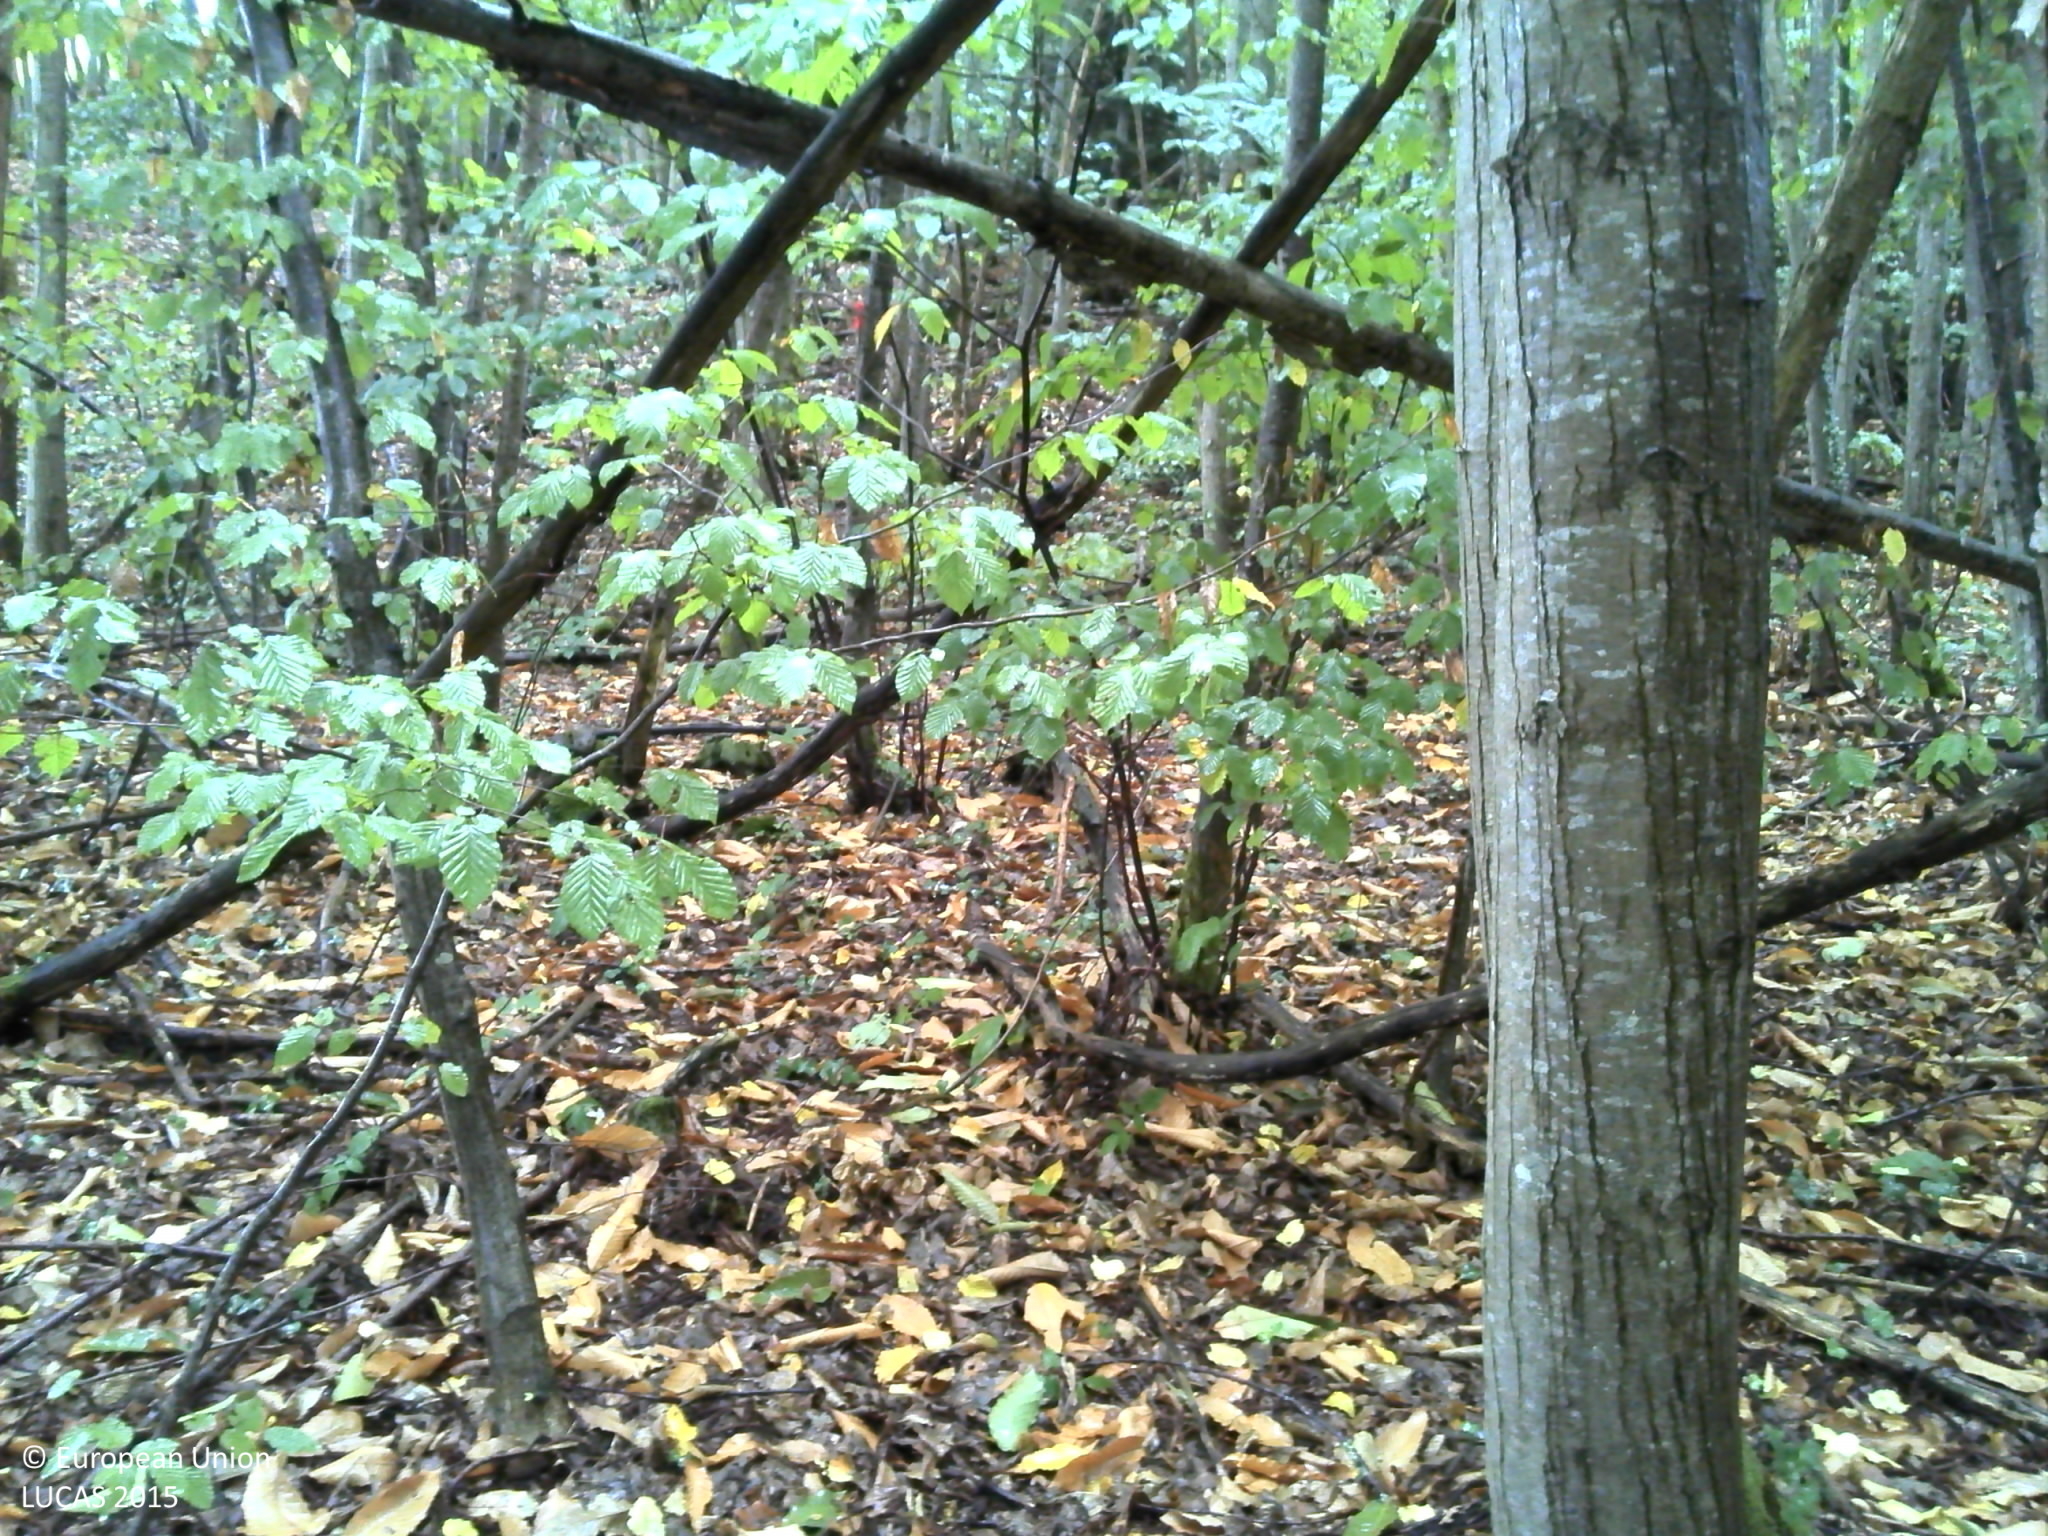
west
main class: Woodland
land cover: Broadleaved woodland
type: mesophytic deciduous forest
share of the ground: > 75 %
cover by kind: broadleaved forest trees 90 %, consolidated bare surface 10 %
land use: Forestry
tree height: > 5 m
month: September
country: FR
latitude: 48.3523
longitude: 7.2885
